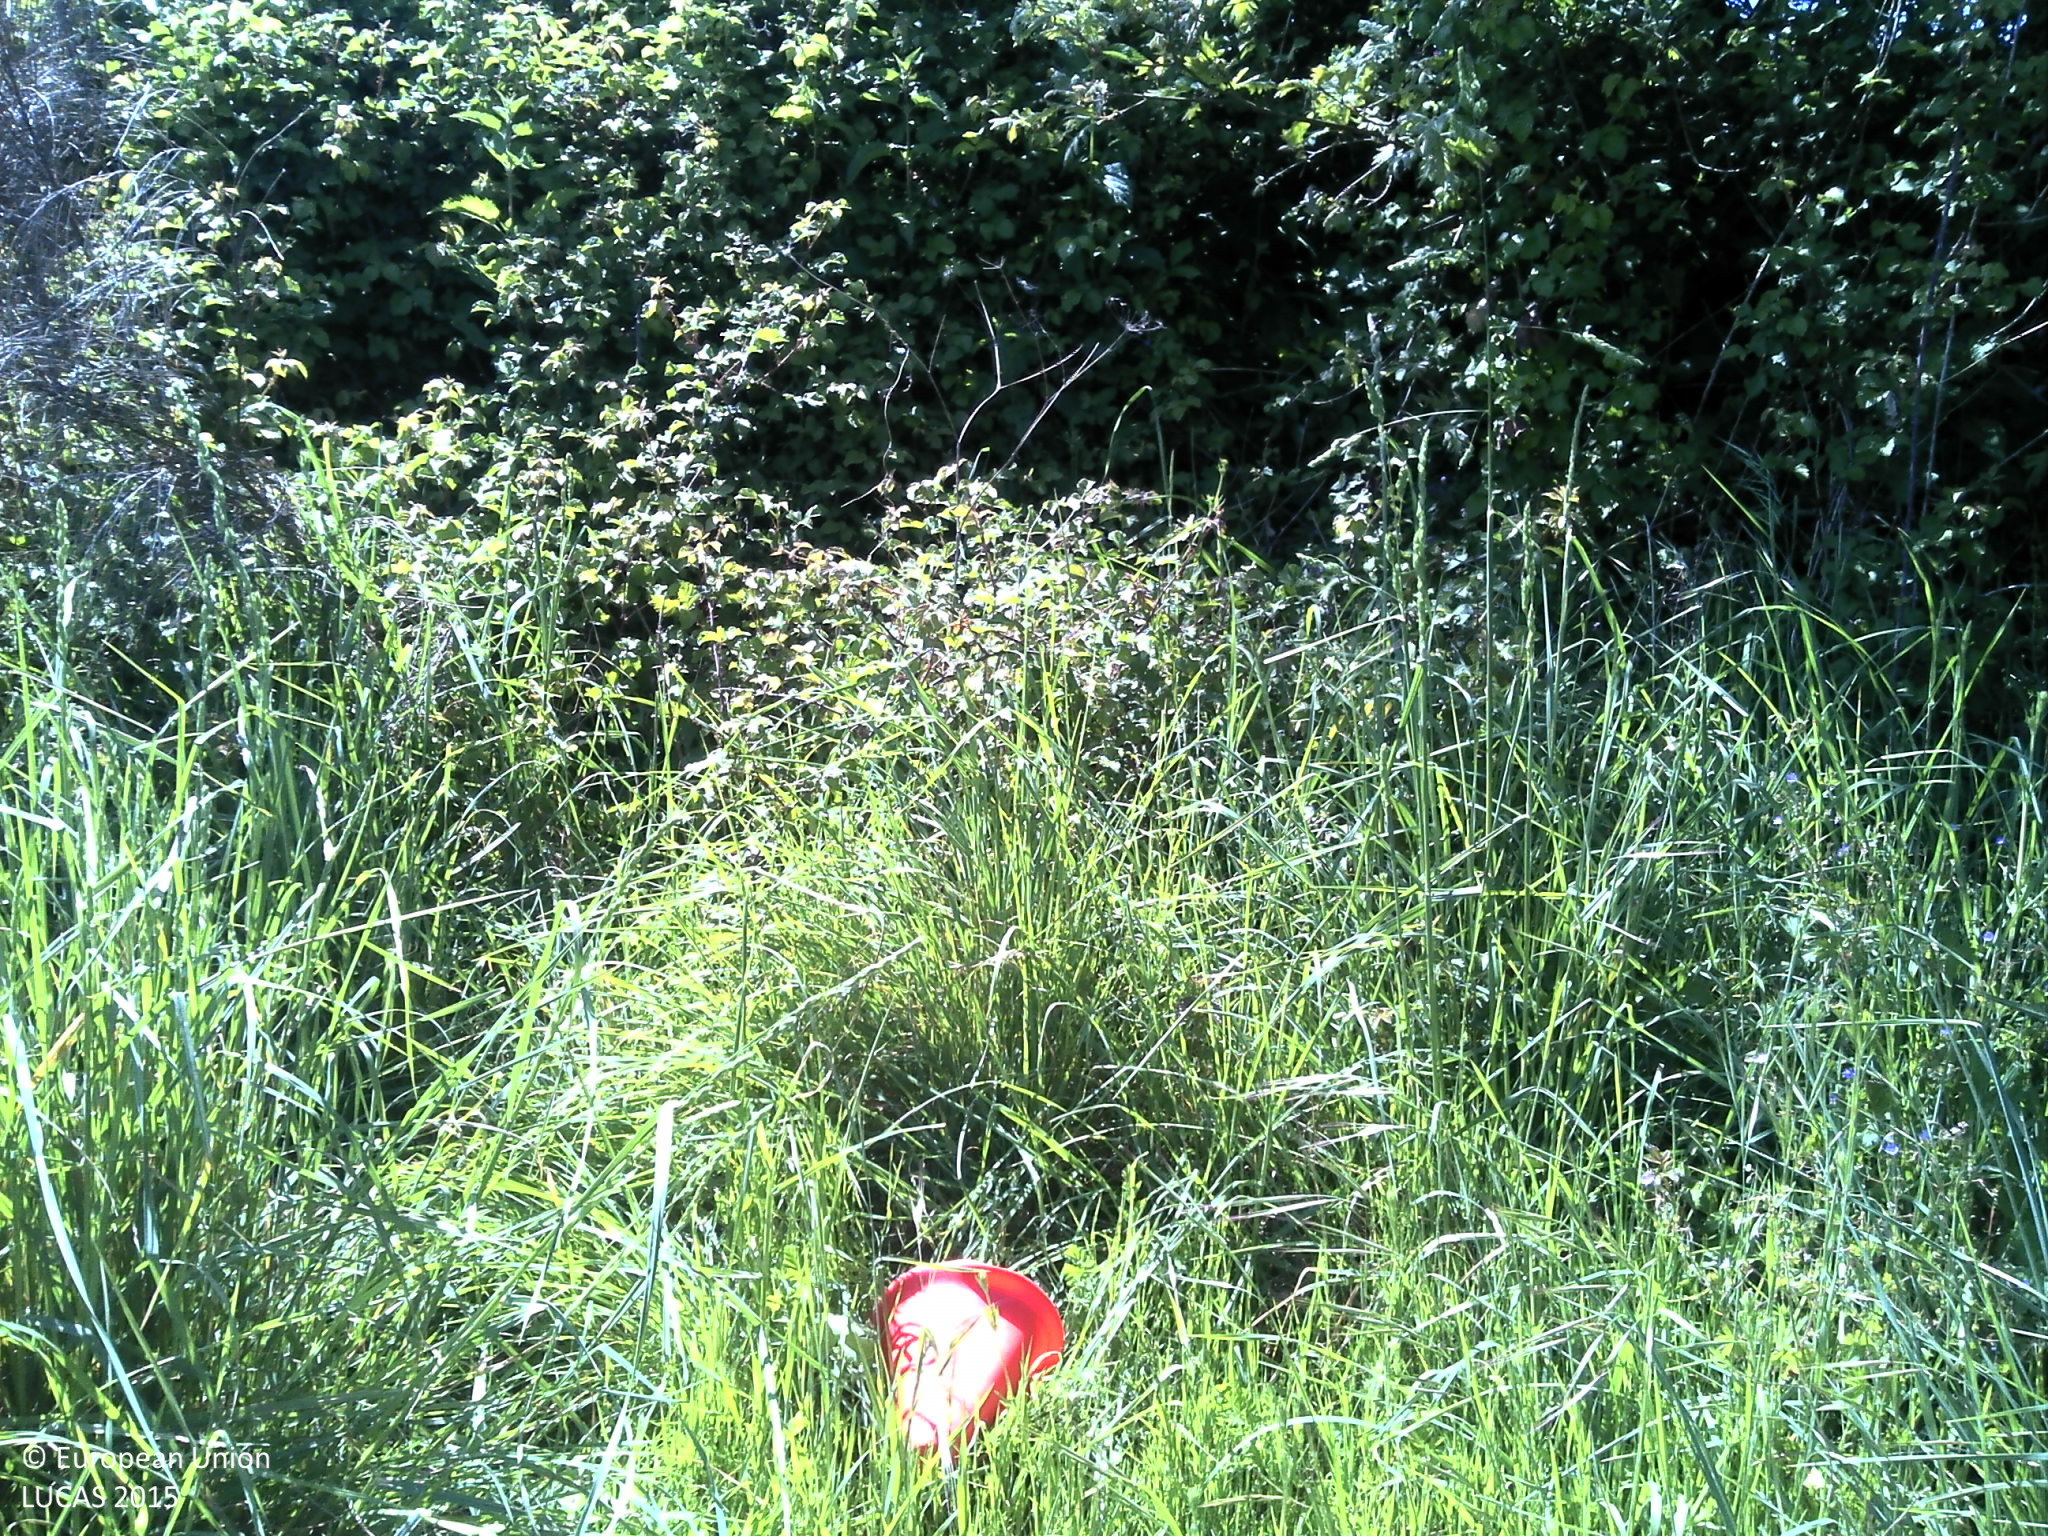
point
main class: Grassland
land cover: Grassland with sparse tree/shrub cover
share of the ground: > 75 %
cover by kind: herbaceous plants 80 %, shrubs 10 %, broadleaved forest trees 5 %, unconsolidated bare surface 5 %
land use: Agriculture (excluding fallow land and kitchen gardens)
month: May
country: PT
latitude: 41.0062
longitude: -7.9050
